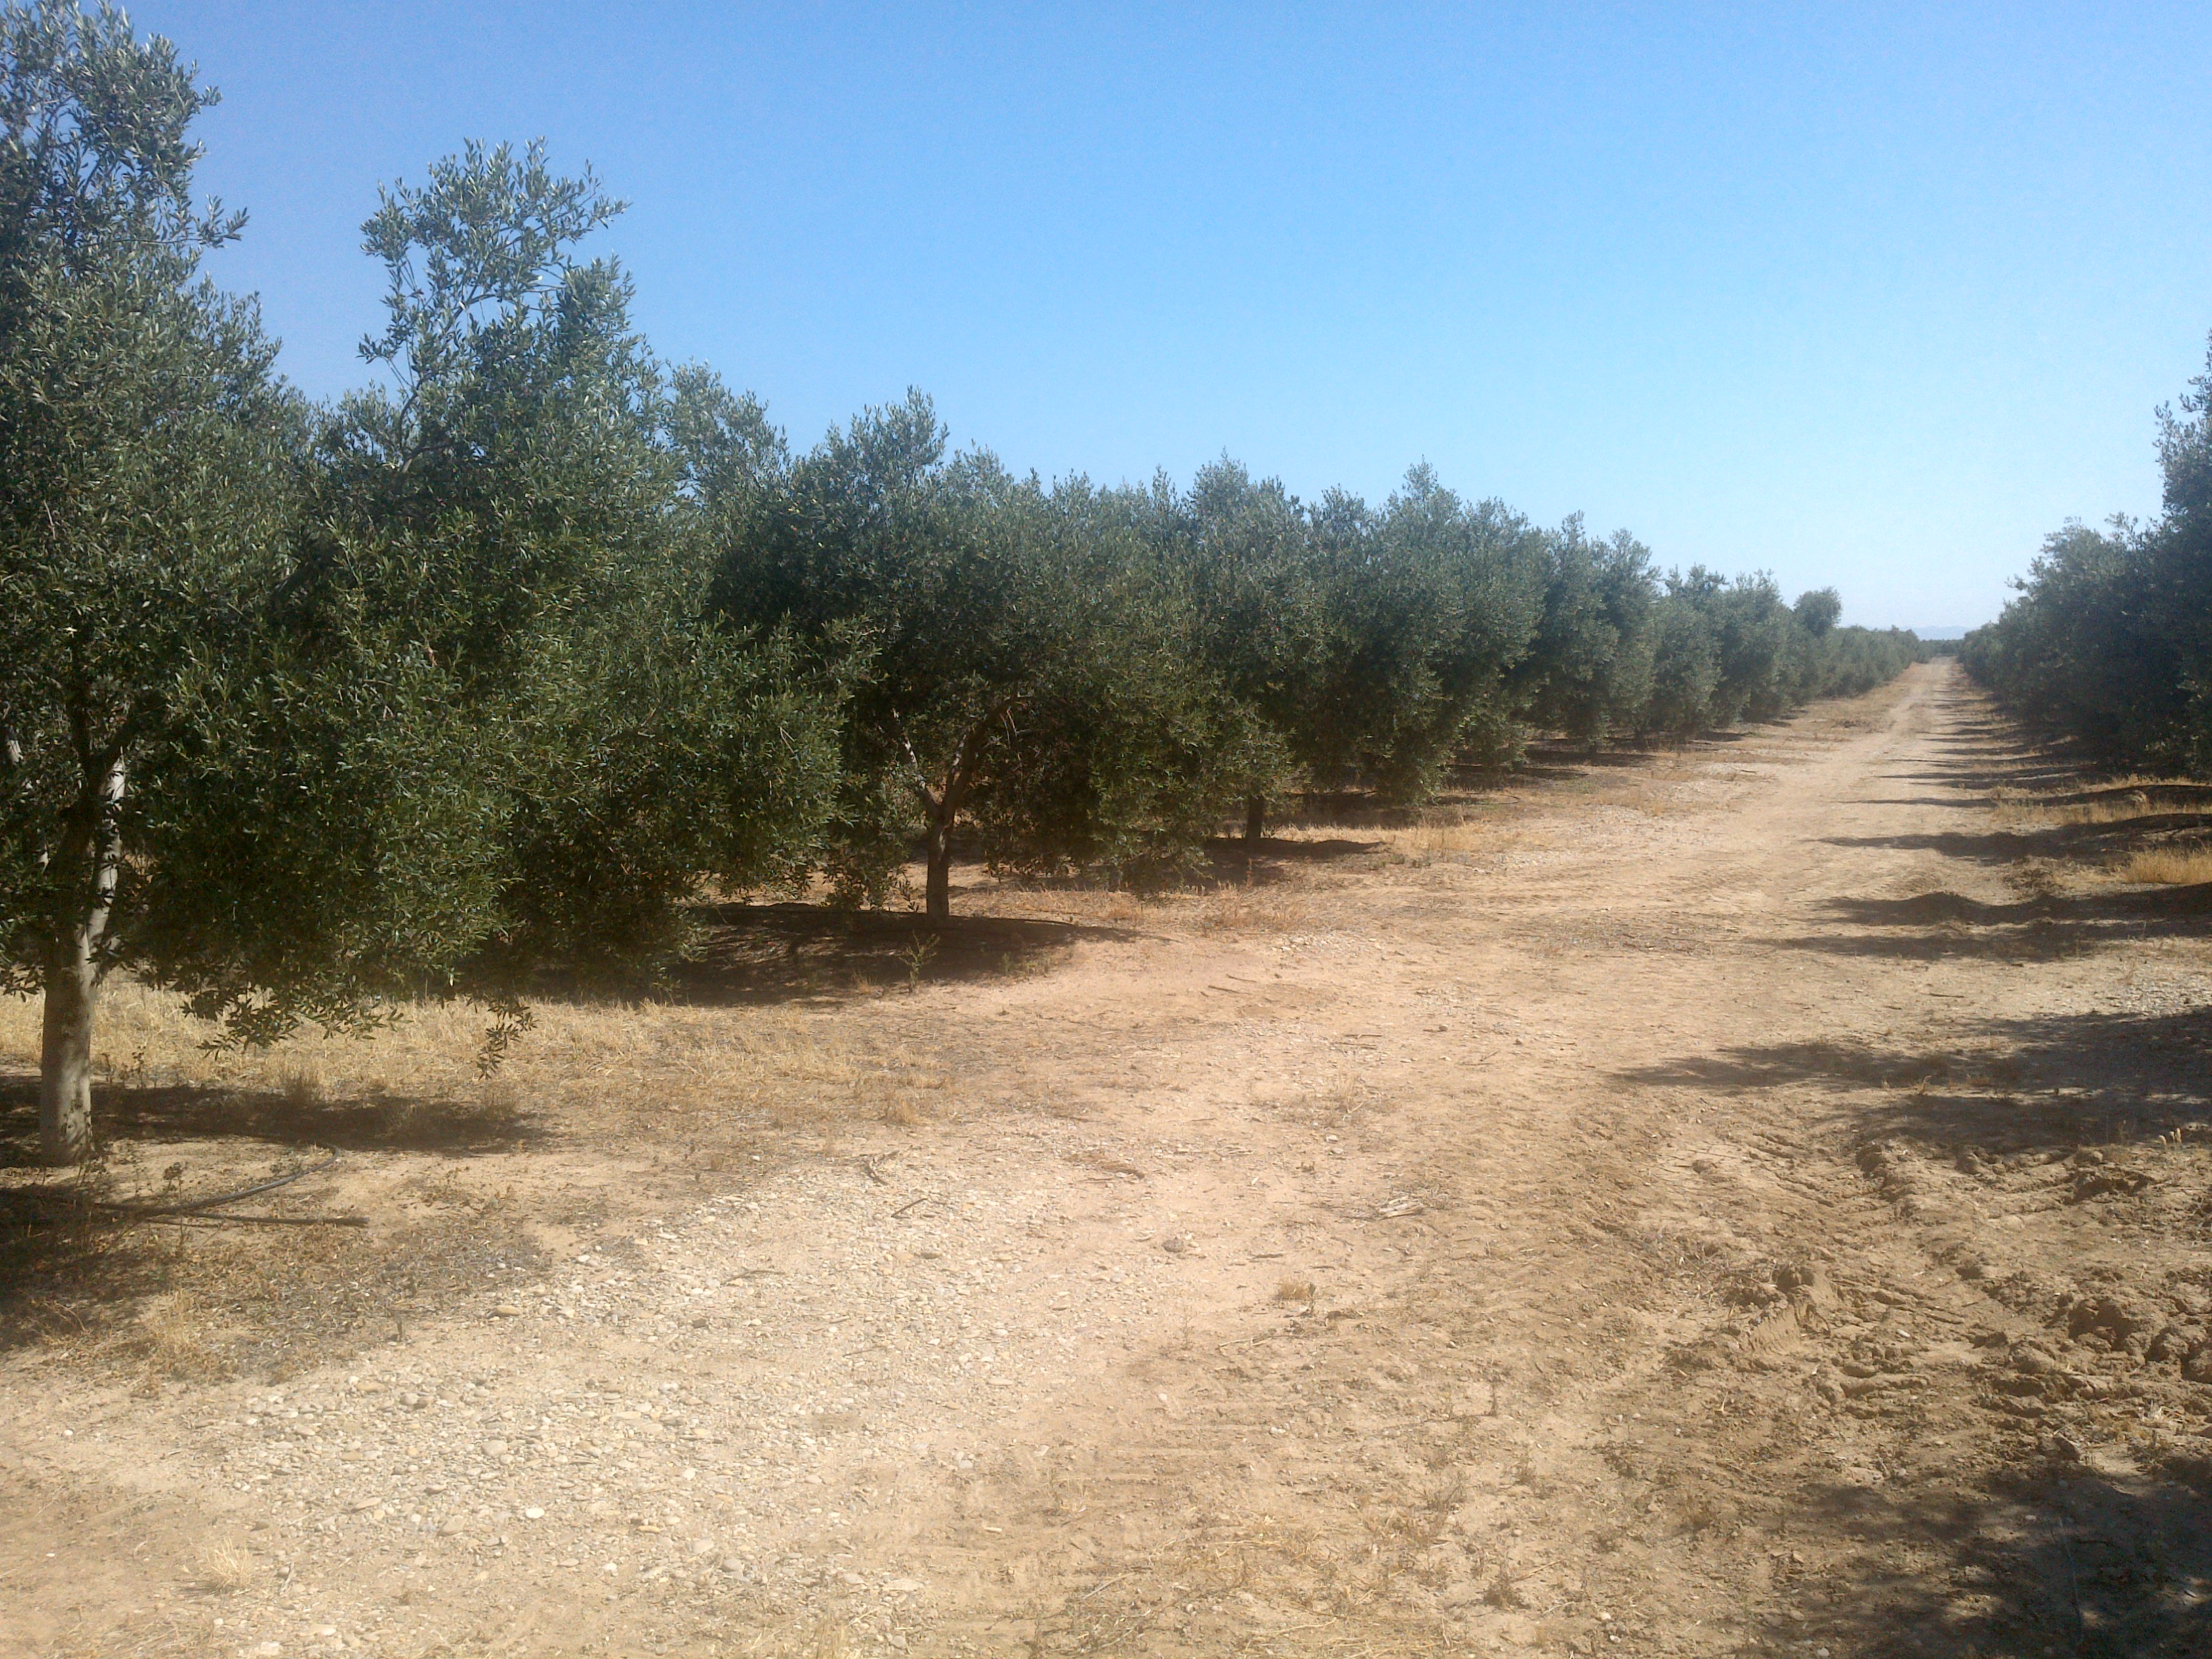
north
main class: Cropland
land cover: Olive groves
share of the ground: 50 - 75 %
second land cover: Spontaneously vegetated surfaces
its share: 10 - 25 %
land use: Agriculture (excluding fallow land and kitchen gardens)
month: June
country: ES
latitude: 37.7134
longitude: -5.2069
